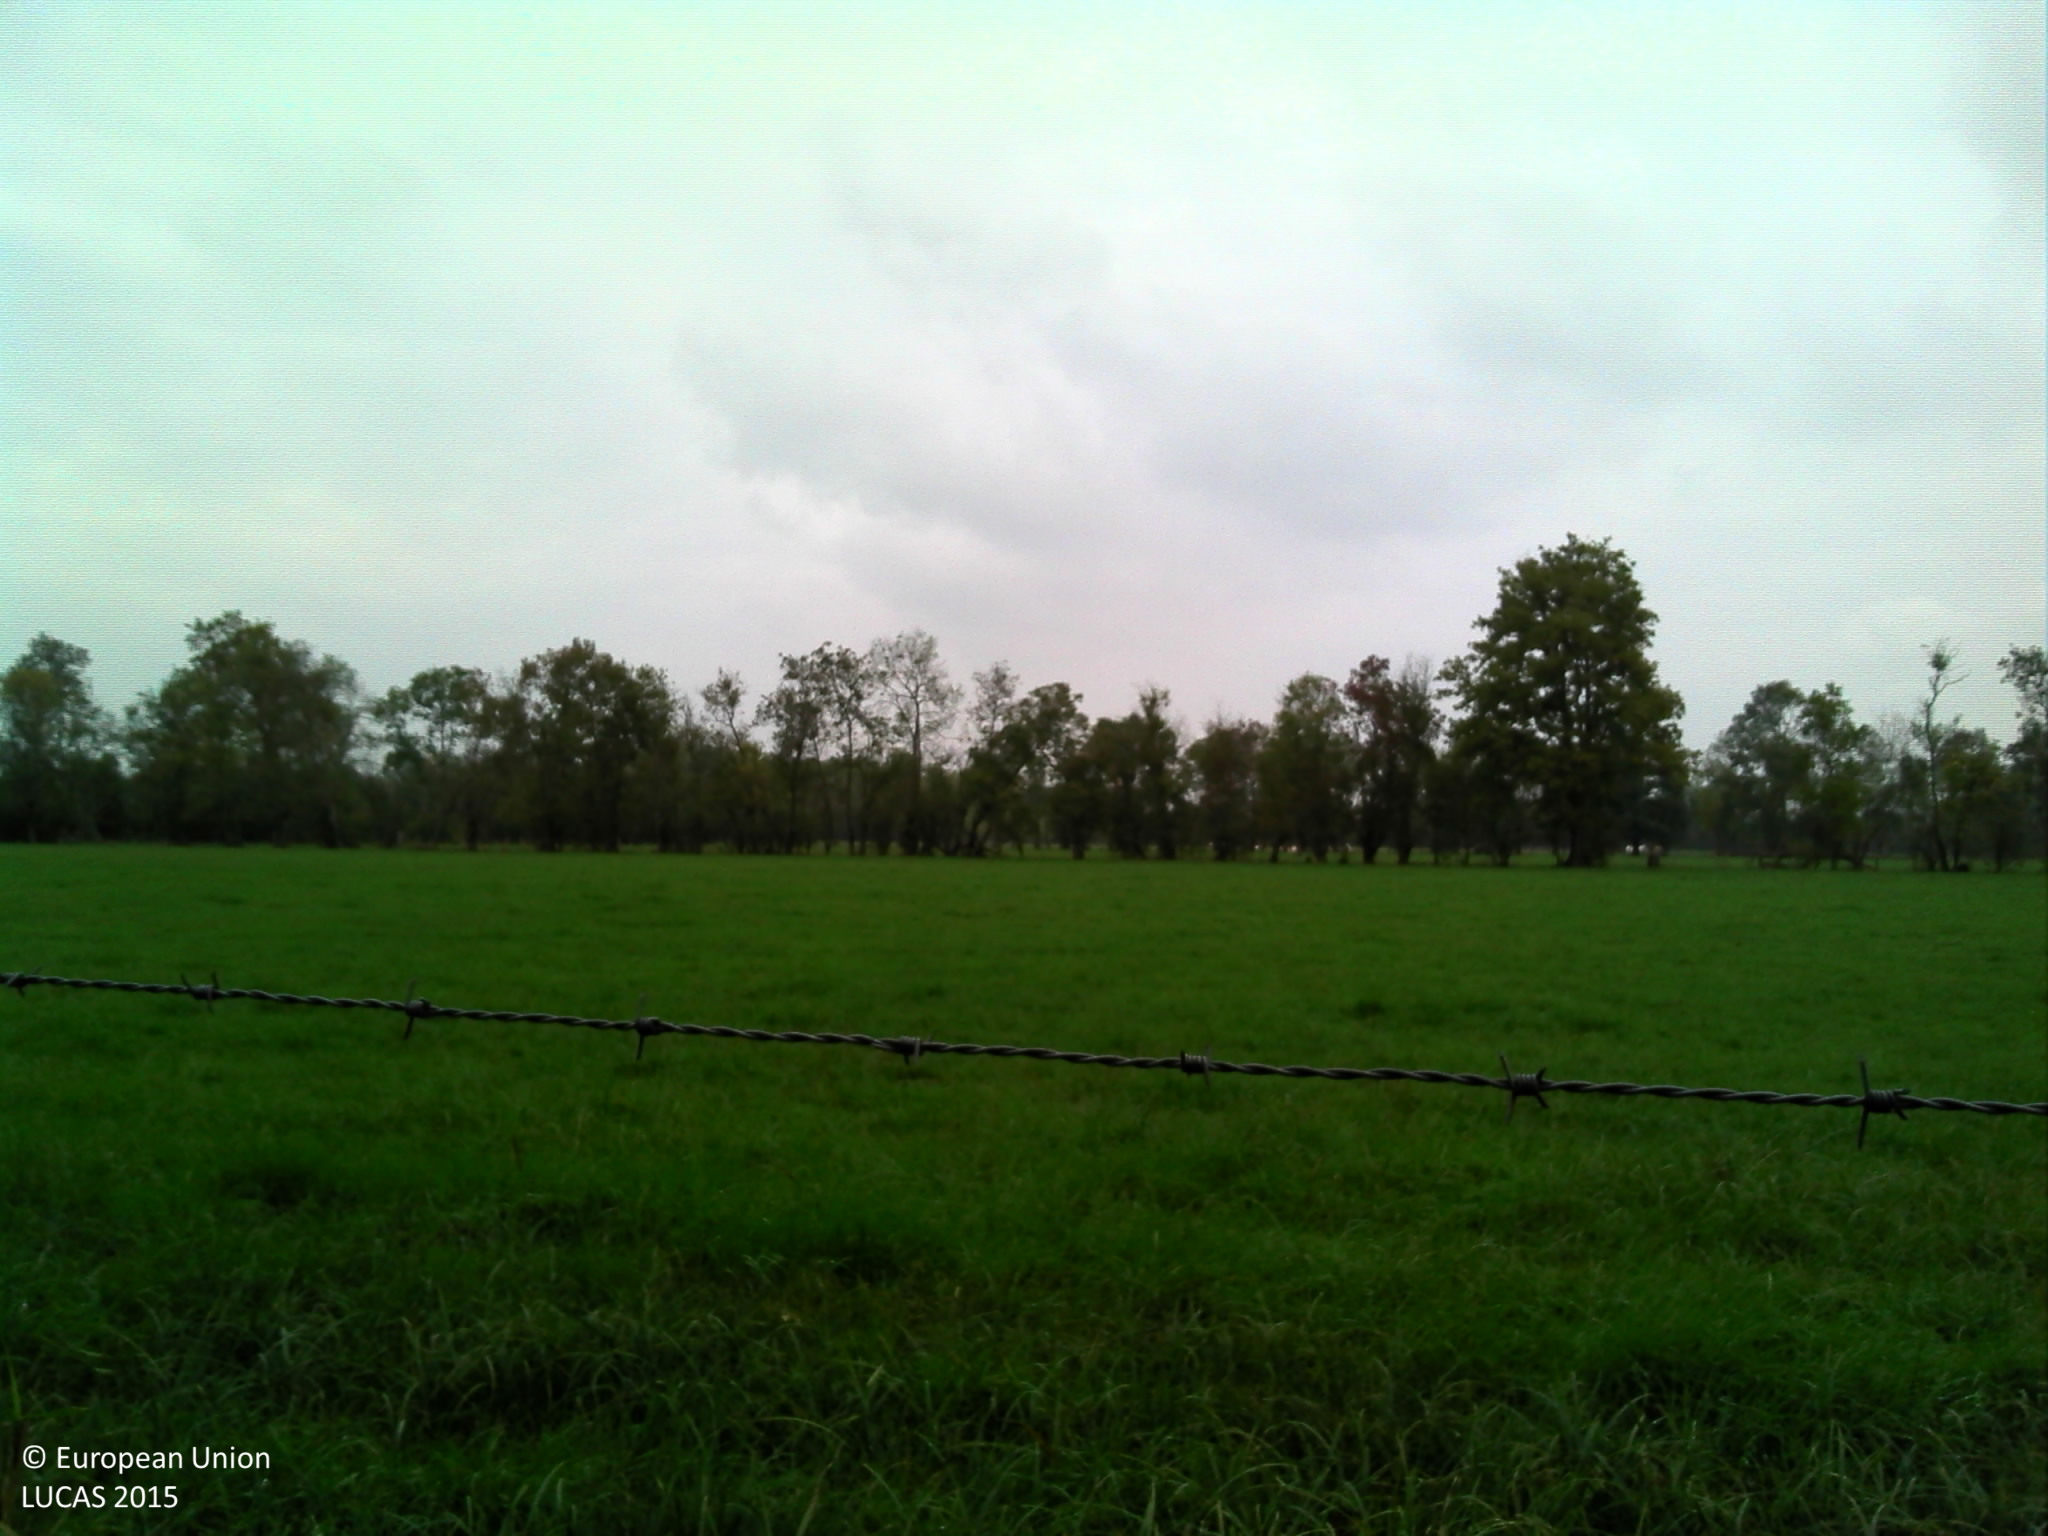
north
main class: Grassland
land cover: Grassland without tree/shrub cover
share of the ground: > 75 %
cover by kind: herbaceous plants 100 %
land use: Agriculture (excluding fallow land and kitchen gardens)
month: October
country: FR
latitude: 46.2070
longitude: 4.8052
